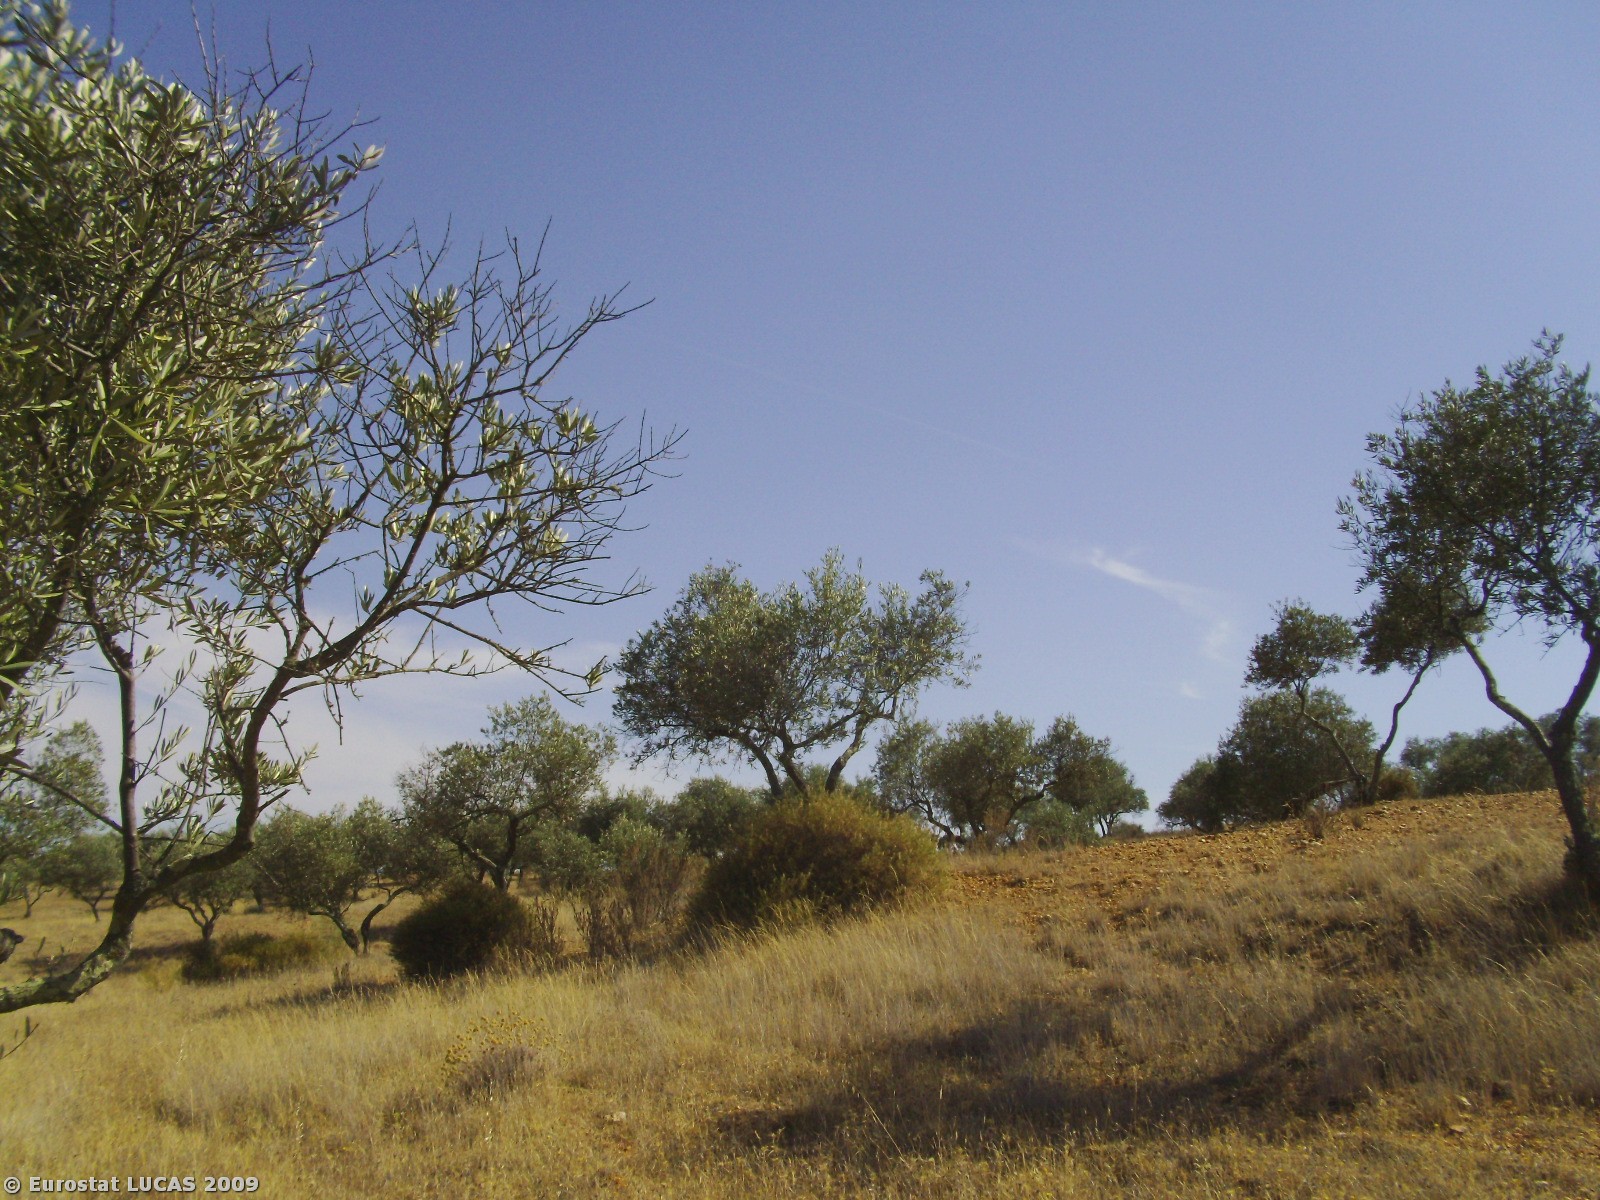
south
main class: Cropland
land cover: Olive groves
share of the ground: 25 - 50 %
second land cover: Spontaneously vegetated surfaces
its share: 25 - 50 %
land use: Agriculture (excluding fallow land and kitchen gardens)
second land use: Fallow land
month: August
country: PT
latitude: 38.1786
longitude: -7.6168
